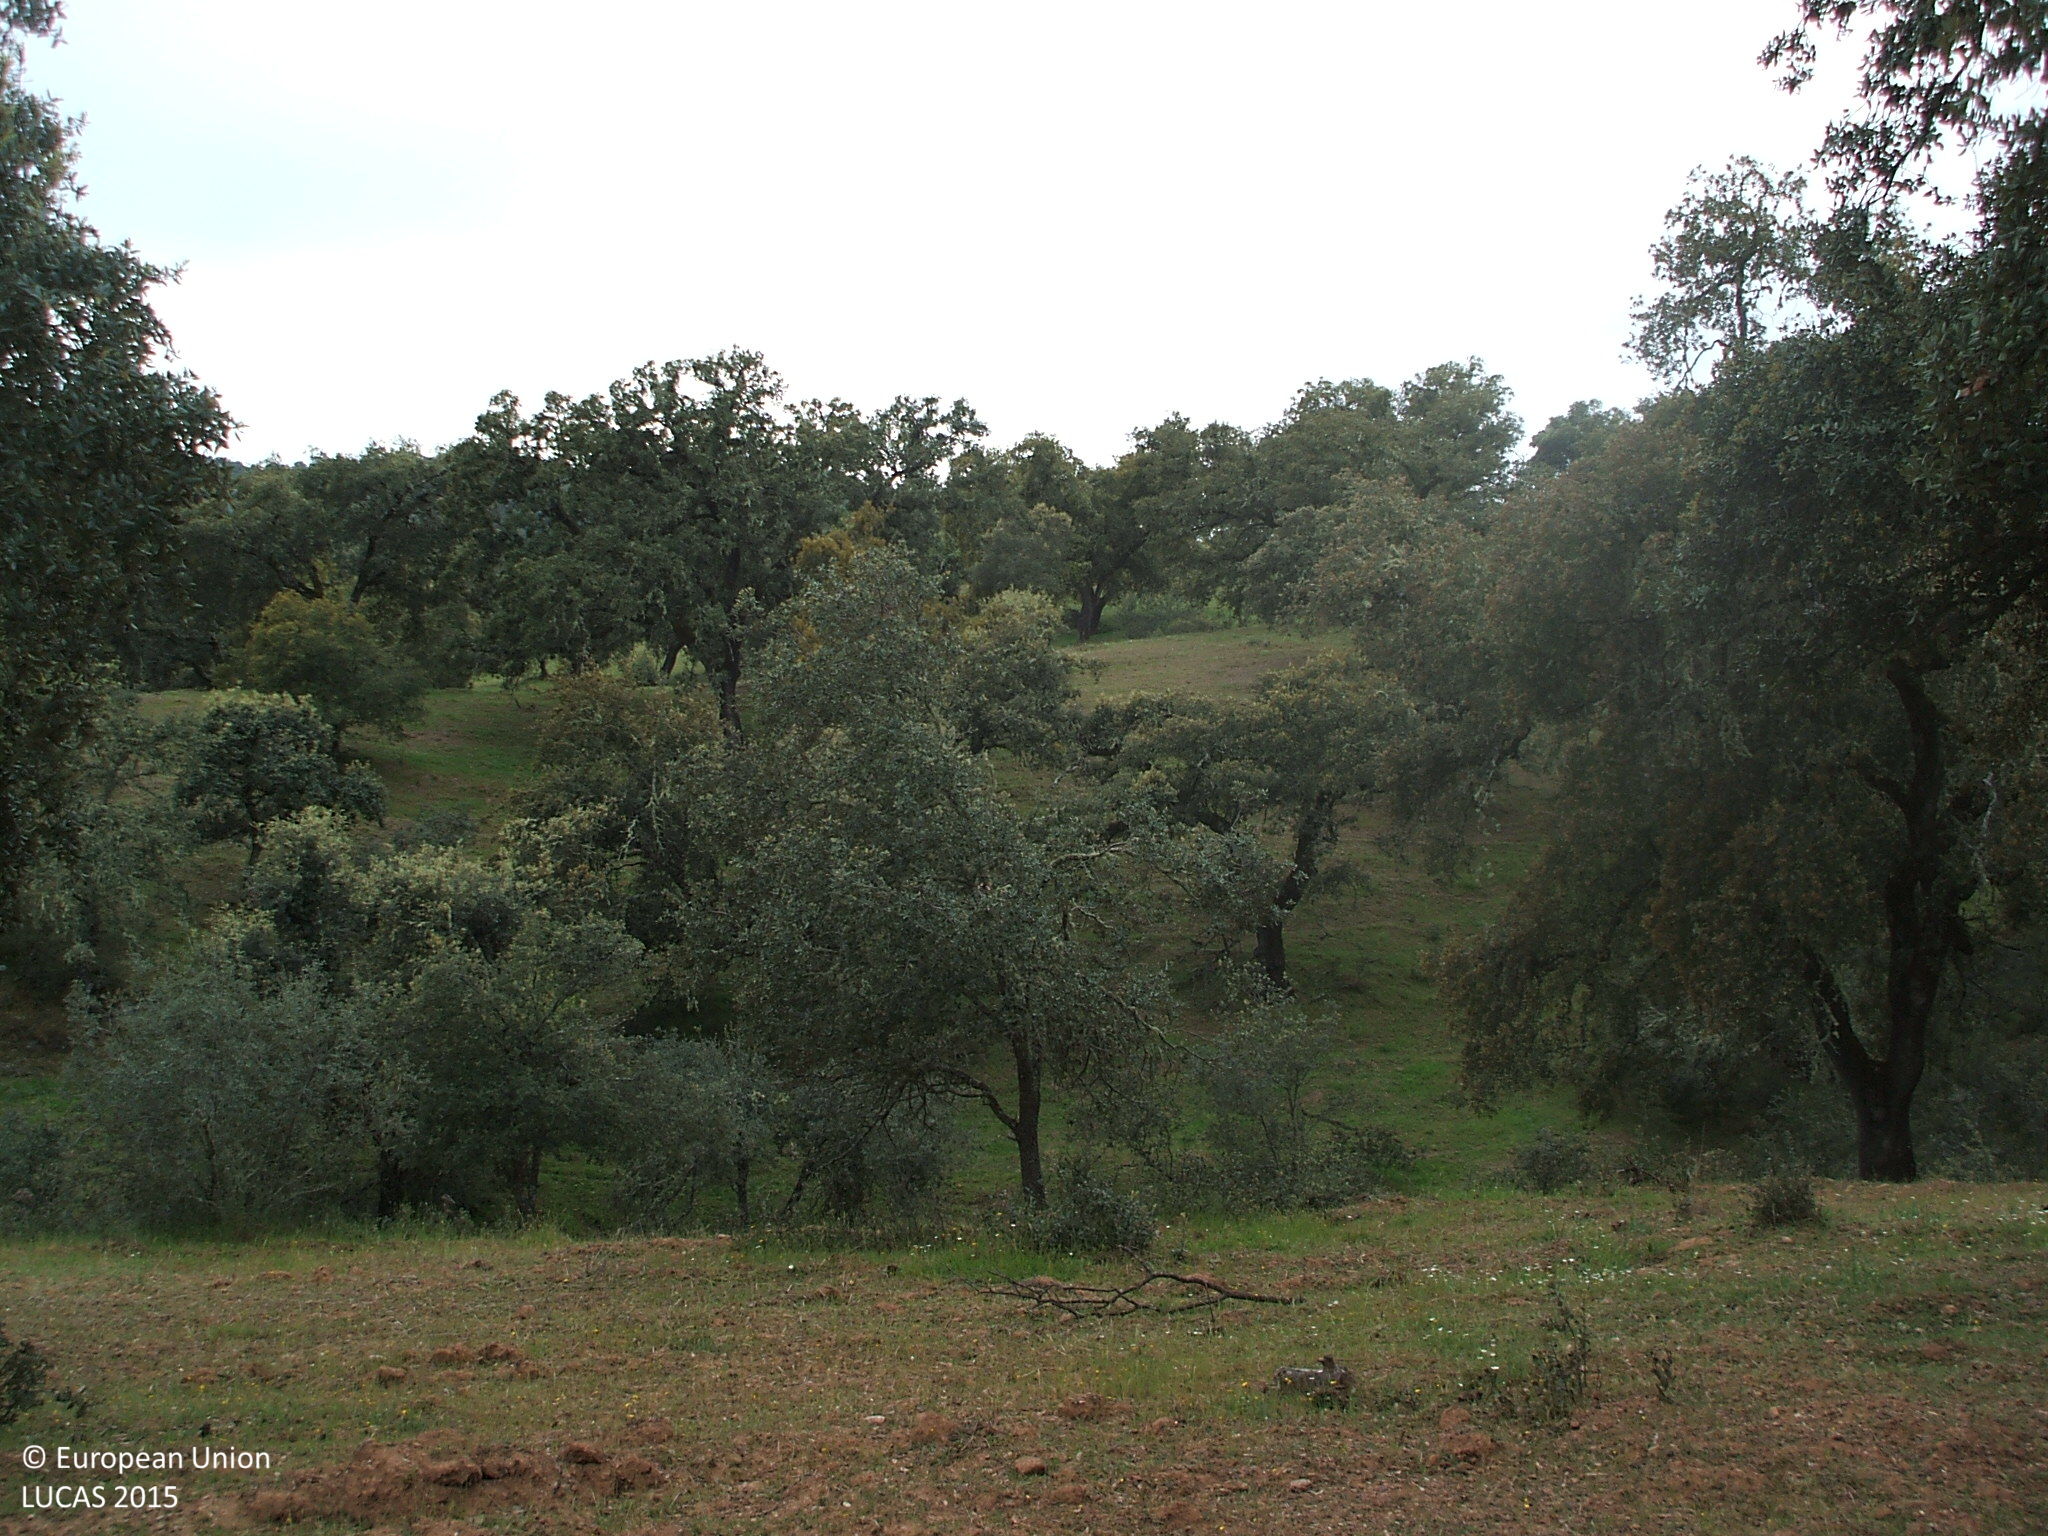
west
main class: Woodland
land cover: Broadleaved woodland
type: broadleaved evergreen forest
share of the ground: 25 - 50 %
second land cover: Grassland without tree/shrub cover
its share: > 75 %
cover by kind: herbaceous plants 60 %, broadleaved forest trees 40 %
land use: Forestry
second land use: Agriculture (excluding fallow land and kitchen gardens)
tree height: > 5 m
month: April
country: ES
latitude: 38.0630
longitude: -5.6568
